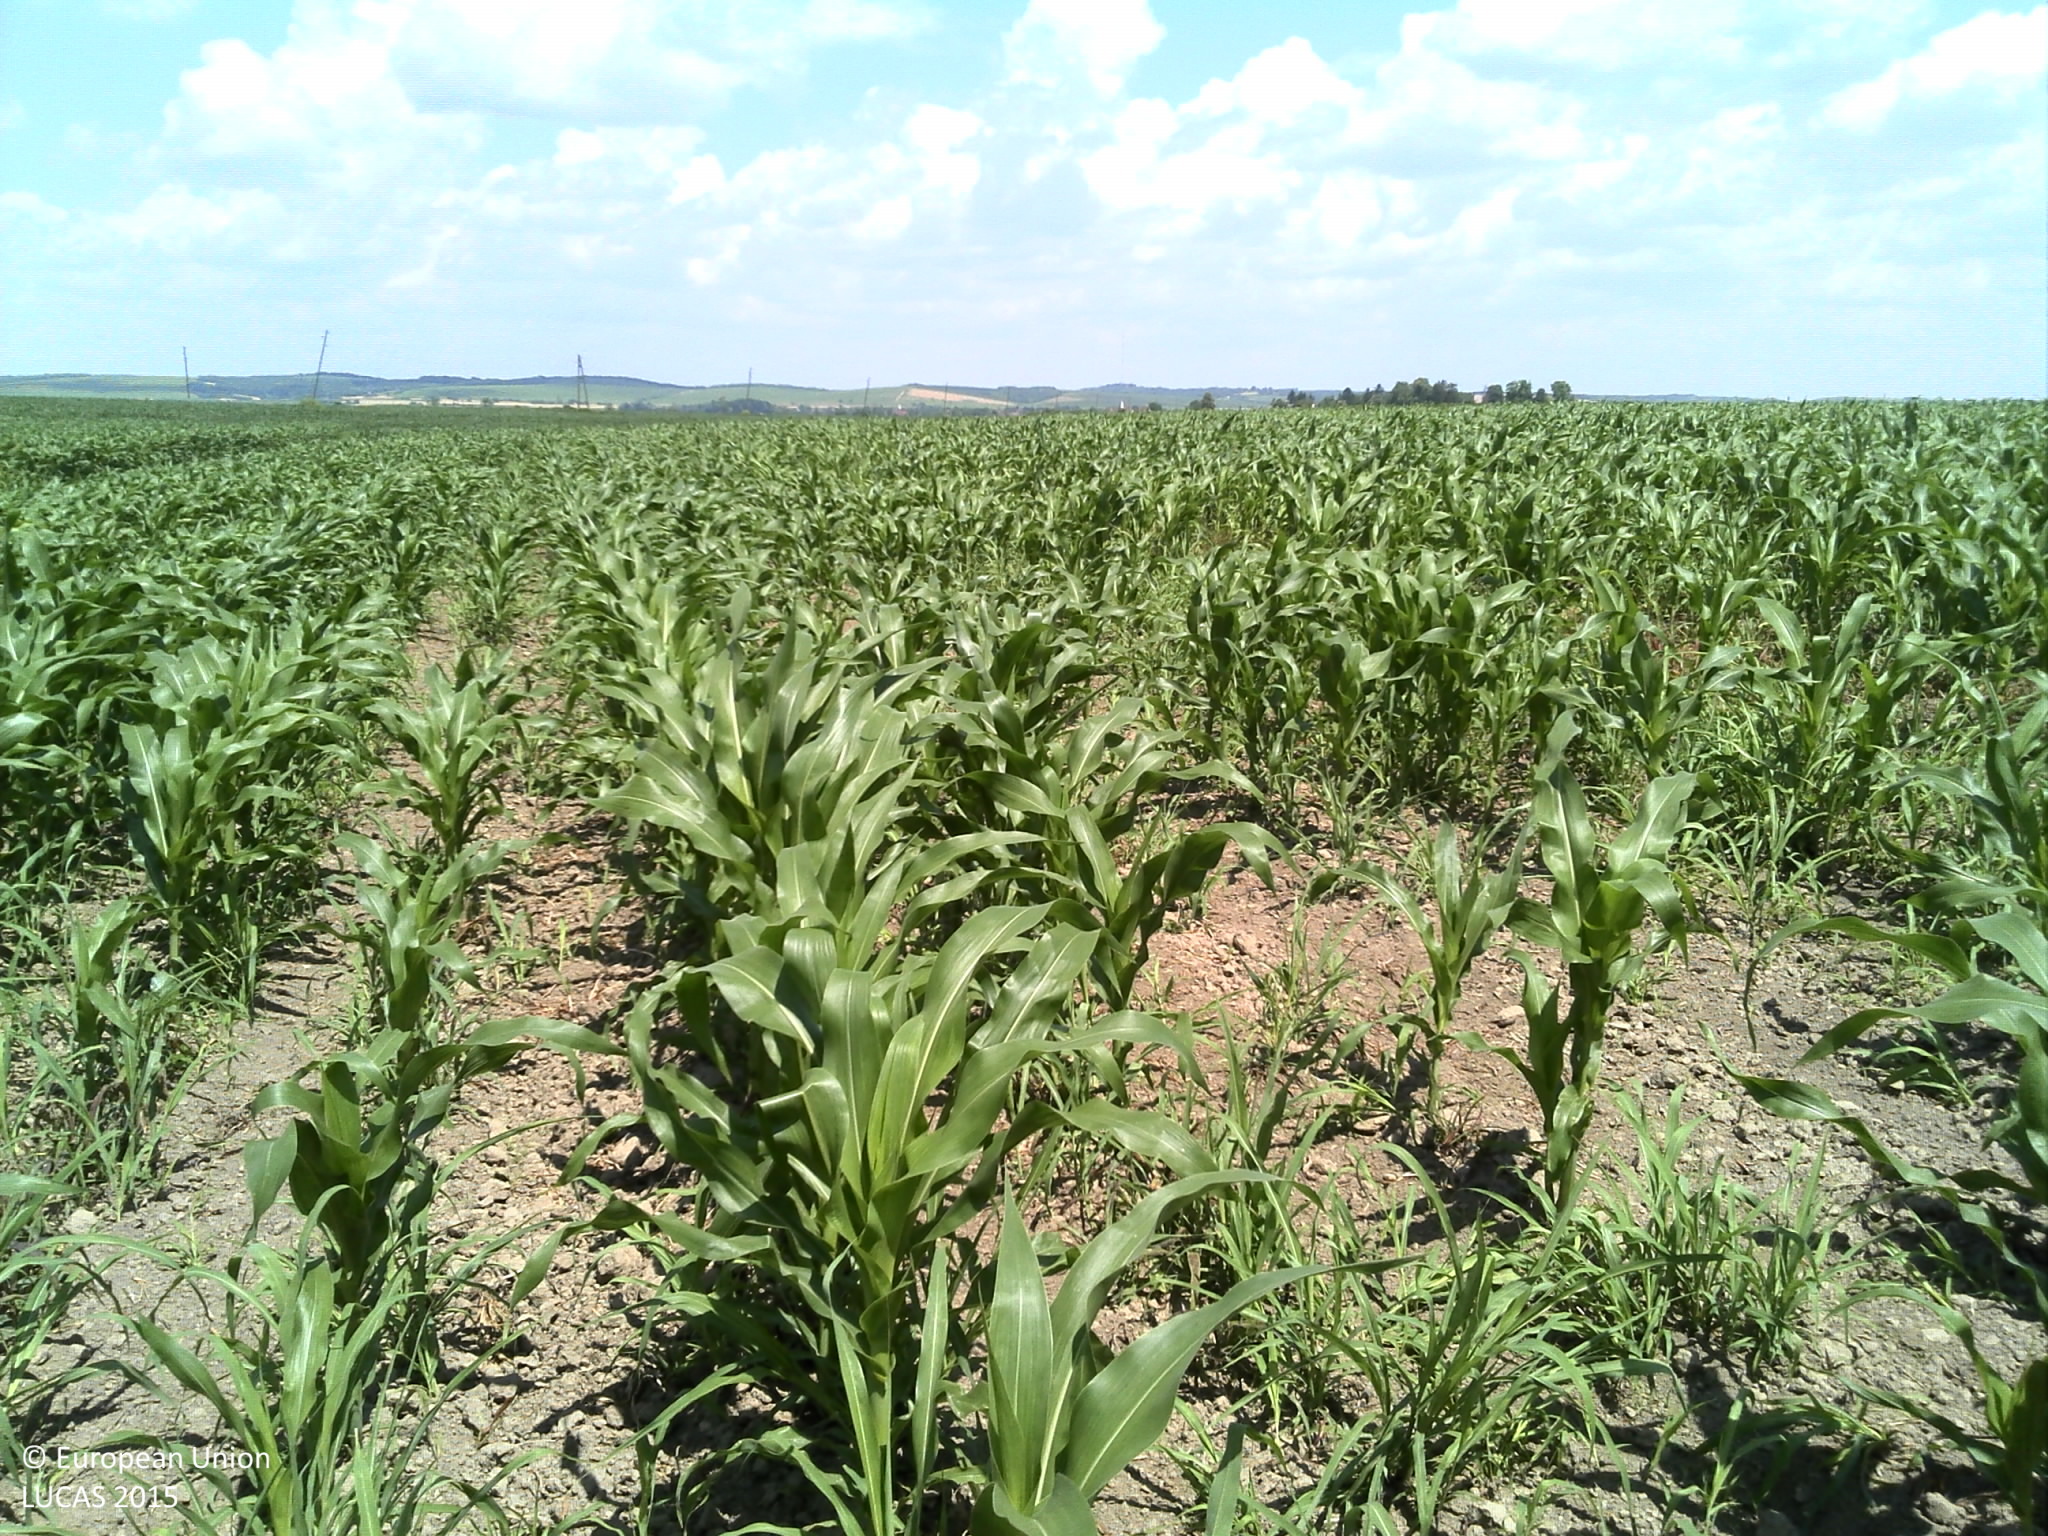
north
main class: Cropland
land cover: Maize
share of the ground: 25 - 50 %
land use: Agriculture (excluding fallow land and kitchen gardens)
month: June
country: HR
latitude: 45.7260
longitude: 18.6816
